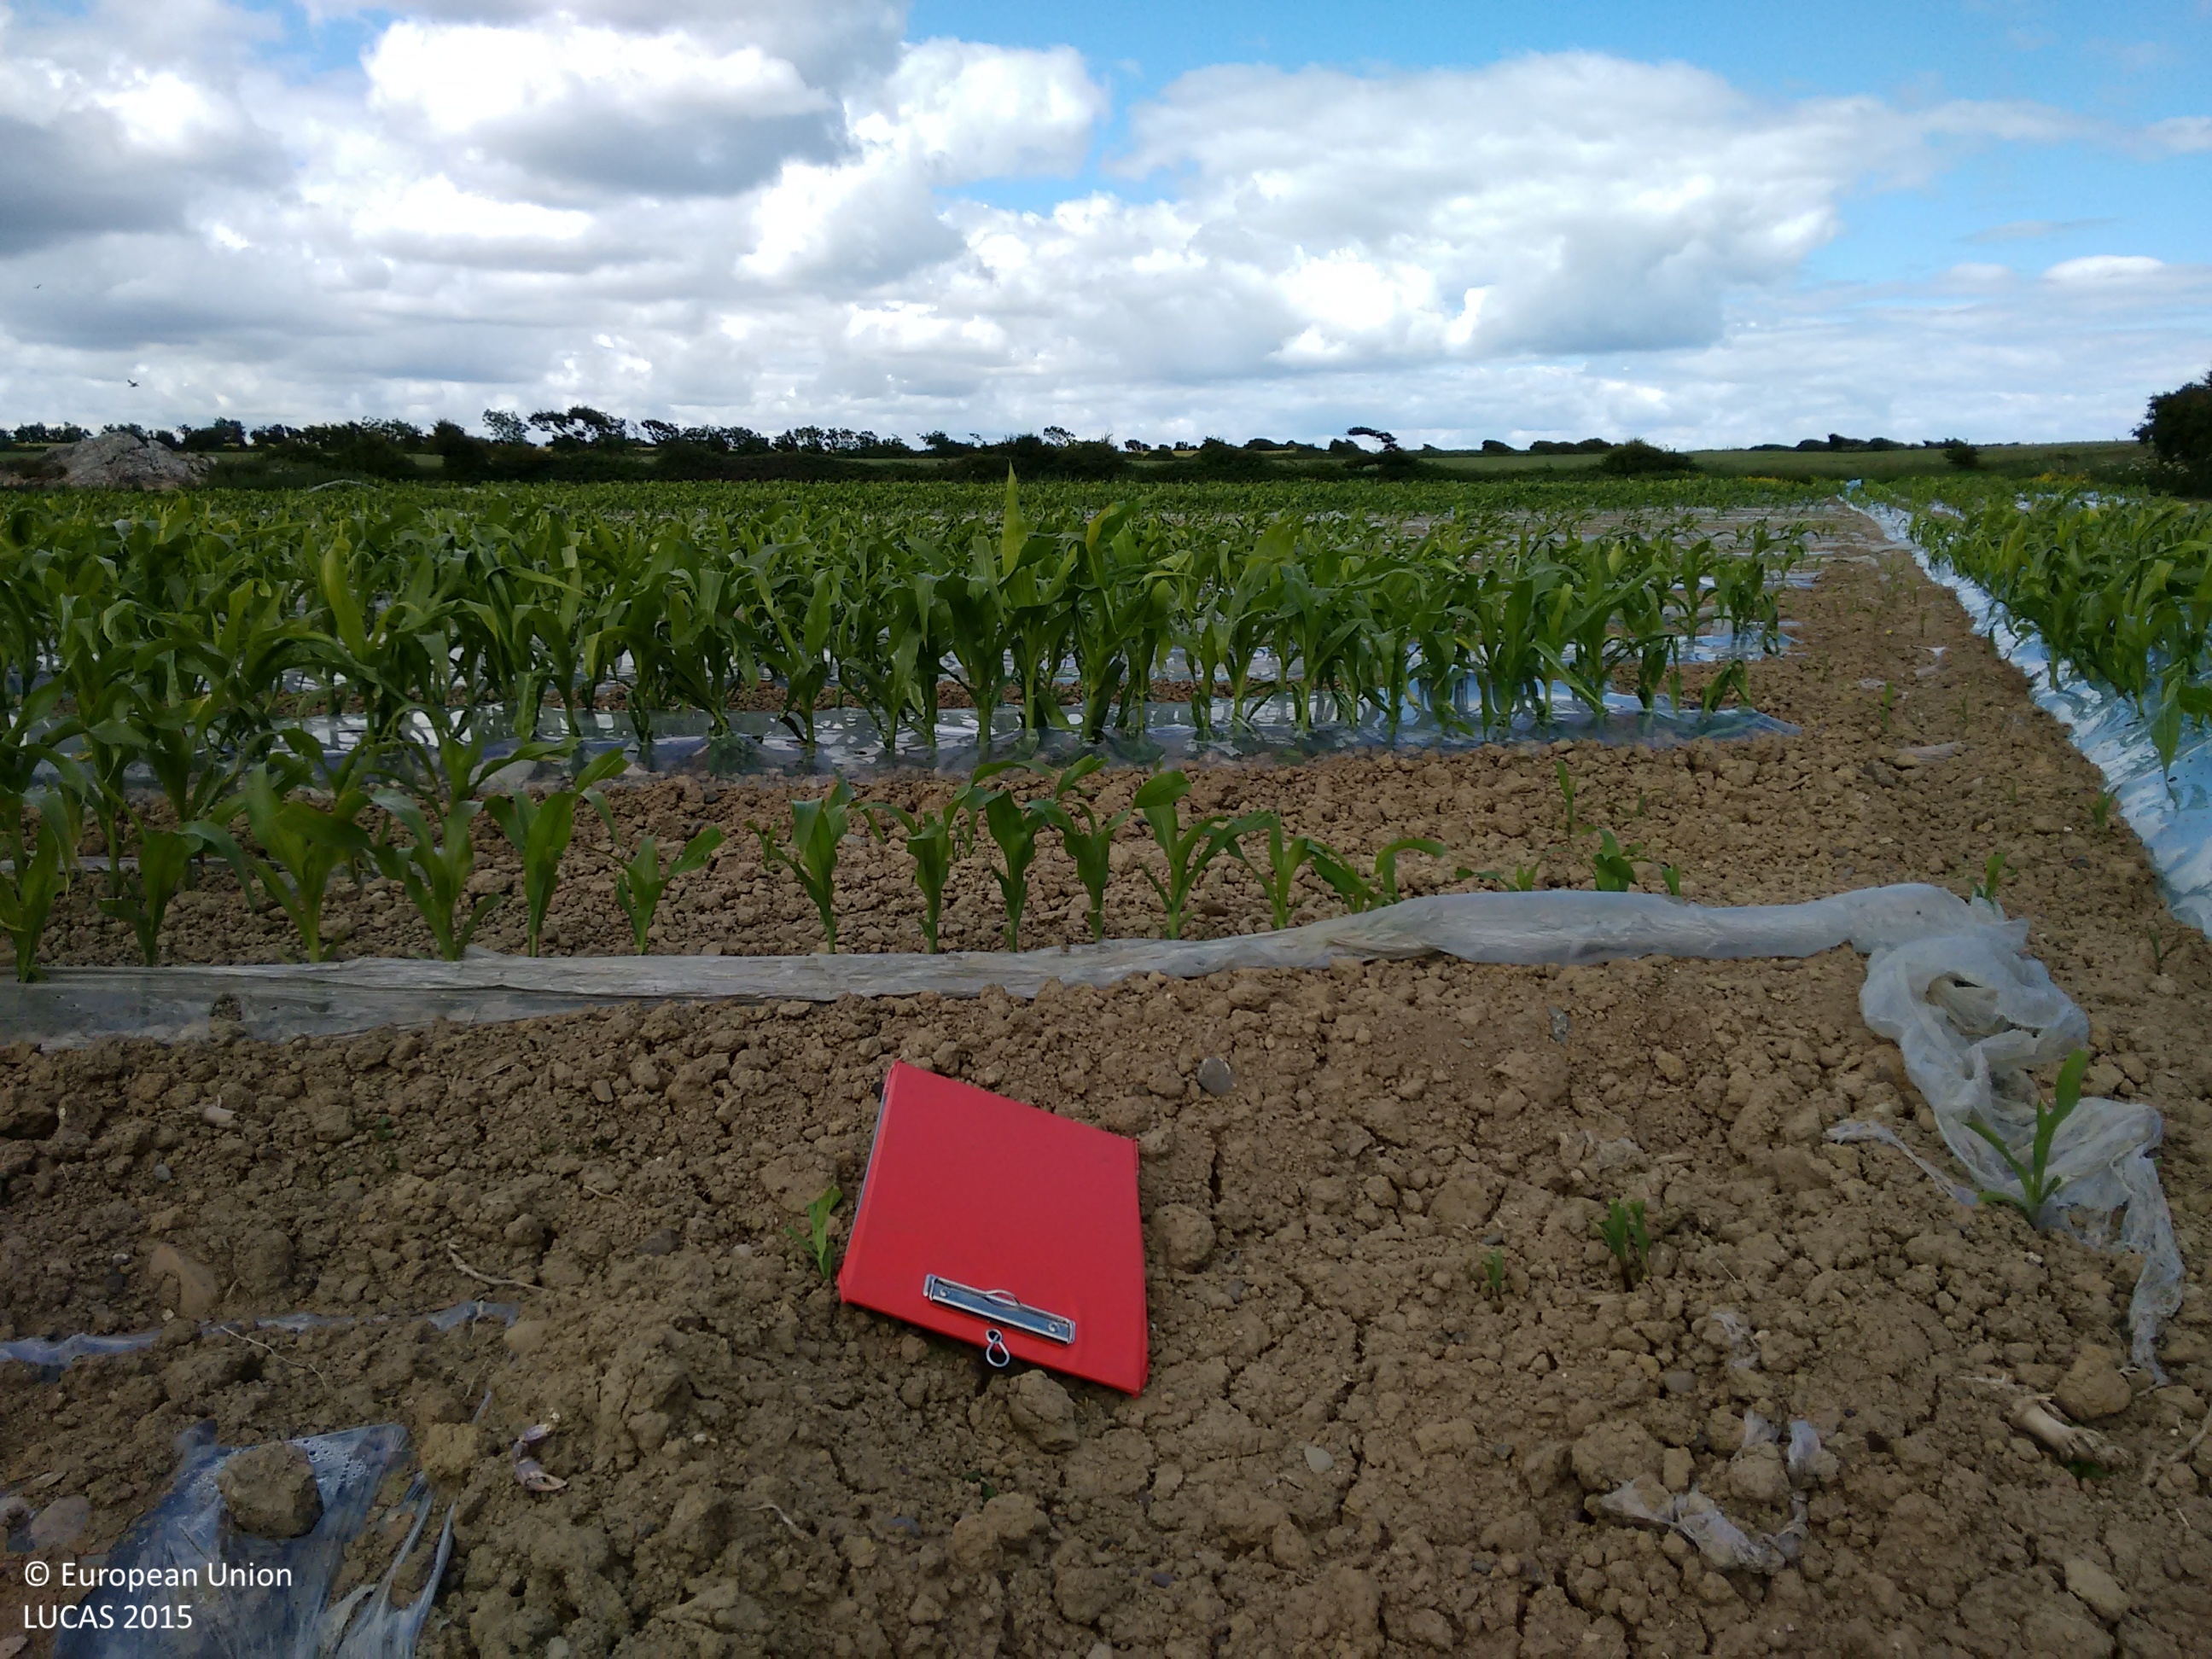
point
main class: Cropland
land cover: Maize
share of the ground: 50 - 75 %
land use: Agriculture (excluding fallow land and kitchen gardens)
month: June
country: IE
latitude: 53.6241
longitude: -6.1896
